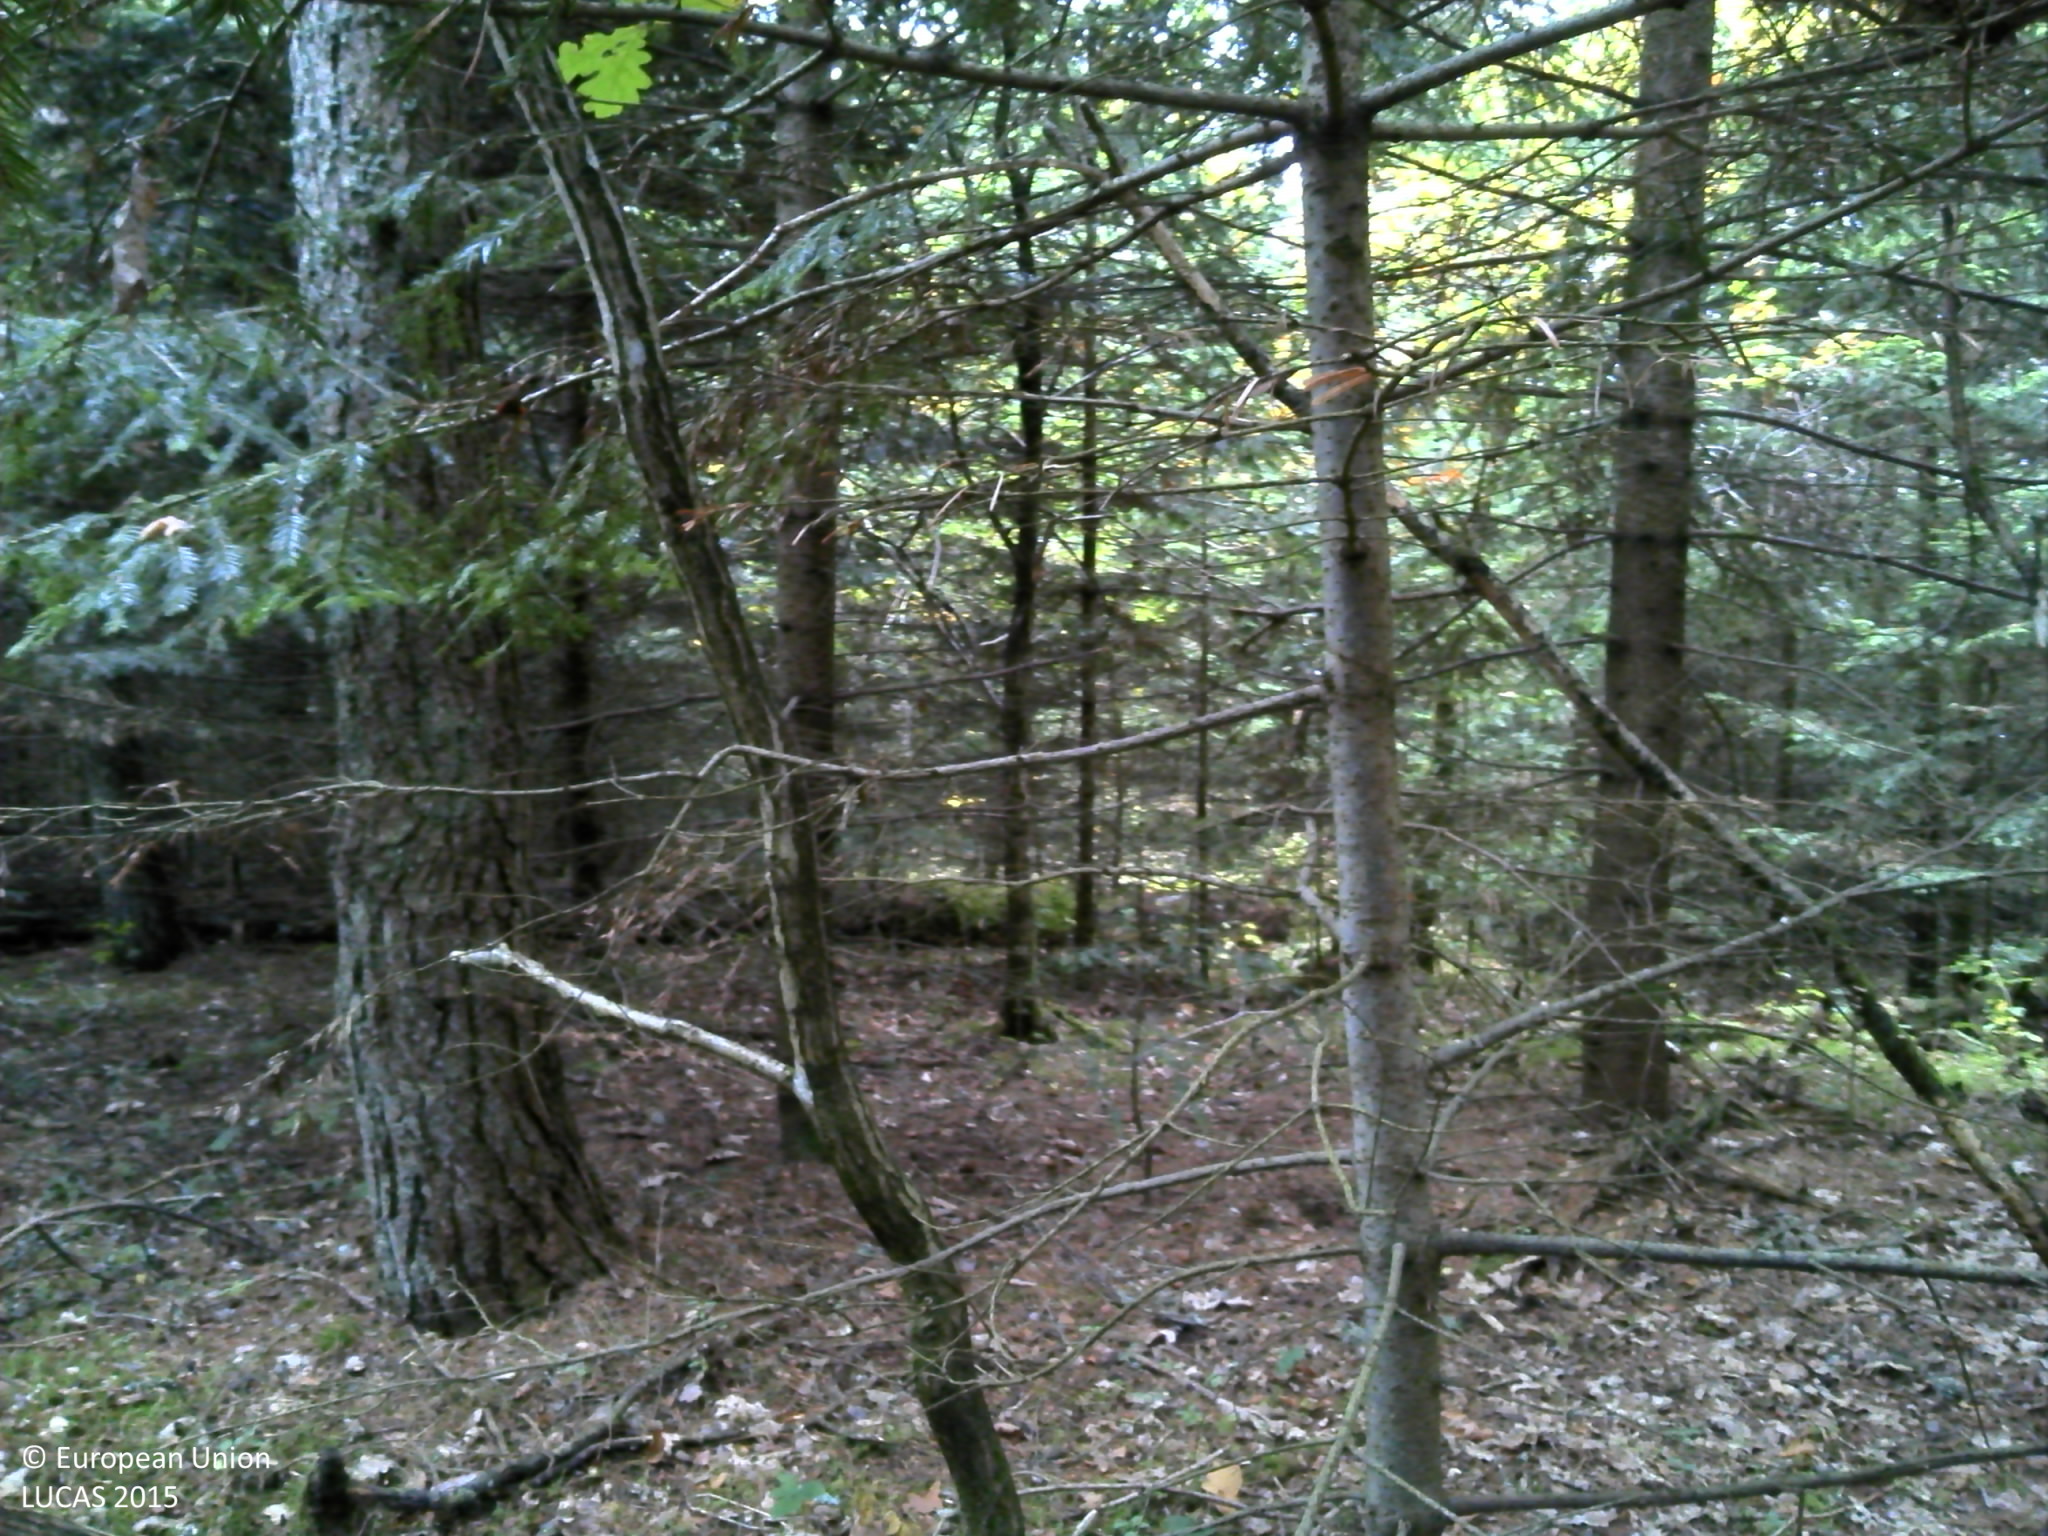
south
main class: Woodland
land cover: Other mixed woodland
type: mesophytic deciduous forest
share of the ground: > 75 %
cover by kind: coniferous forest trees 50 %, broadleaved forest trees 20 %, lichens and mosses 20 %, unconsolidated bare surface 10 %
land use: Forestry
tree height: > 5 m
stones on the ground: < 10 %
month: October
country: FR
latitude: 45.4831
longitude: 3.7719
